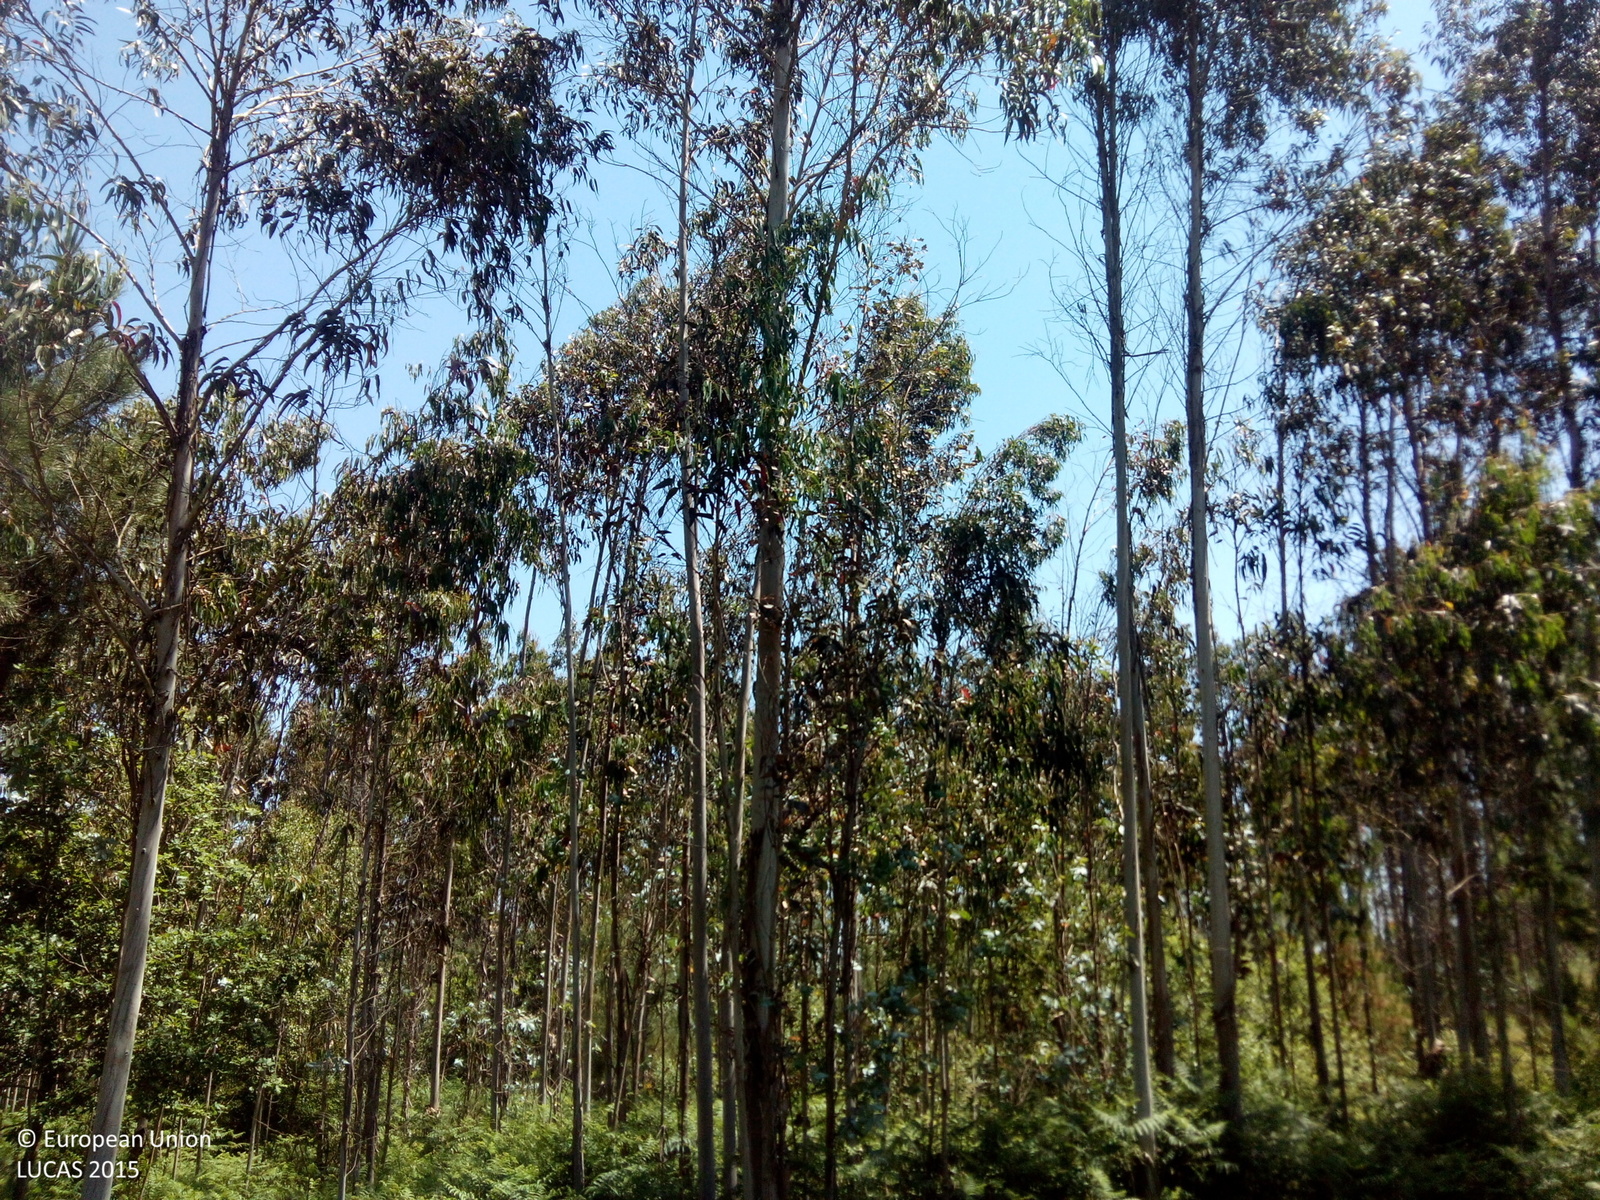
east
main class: Grassland
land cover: Grassland without tree/shrub cover
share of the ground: > 75 %
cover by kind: herbaceous plants 100 %
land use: Agriculture (excluding fallow land and kitchen gardens)
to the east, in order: Grassland without tree/shrub cover; Other mixed woodland; Ditches and canals; Tracks; Other mixed woodland; Spontaneously vegetated surfaces; Artificial constructions in urban areas; Spontaneously vegetated surfaces
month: May
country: ES
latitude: 42.8281
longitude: -8.5386
